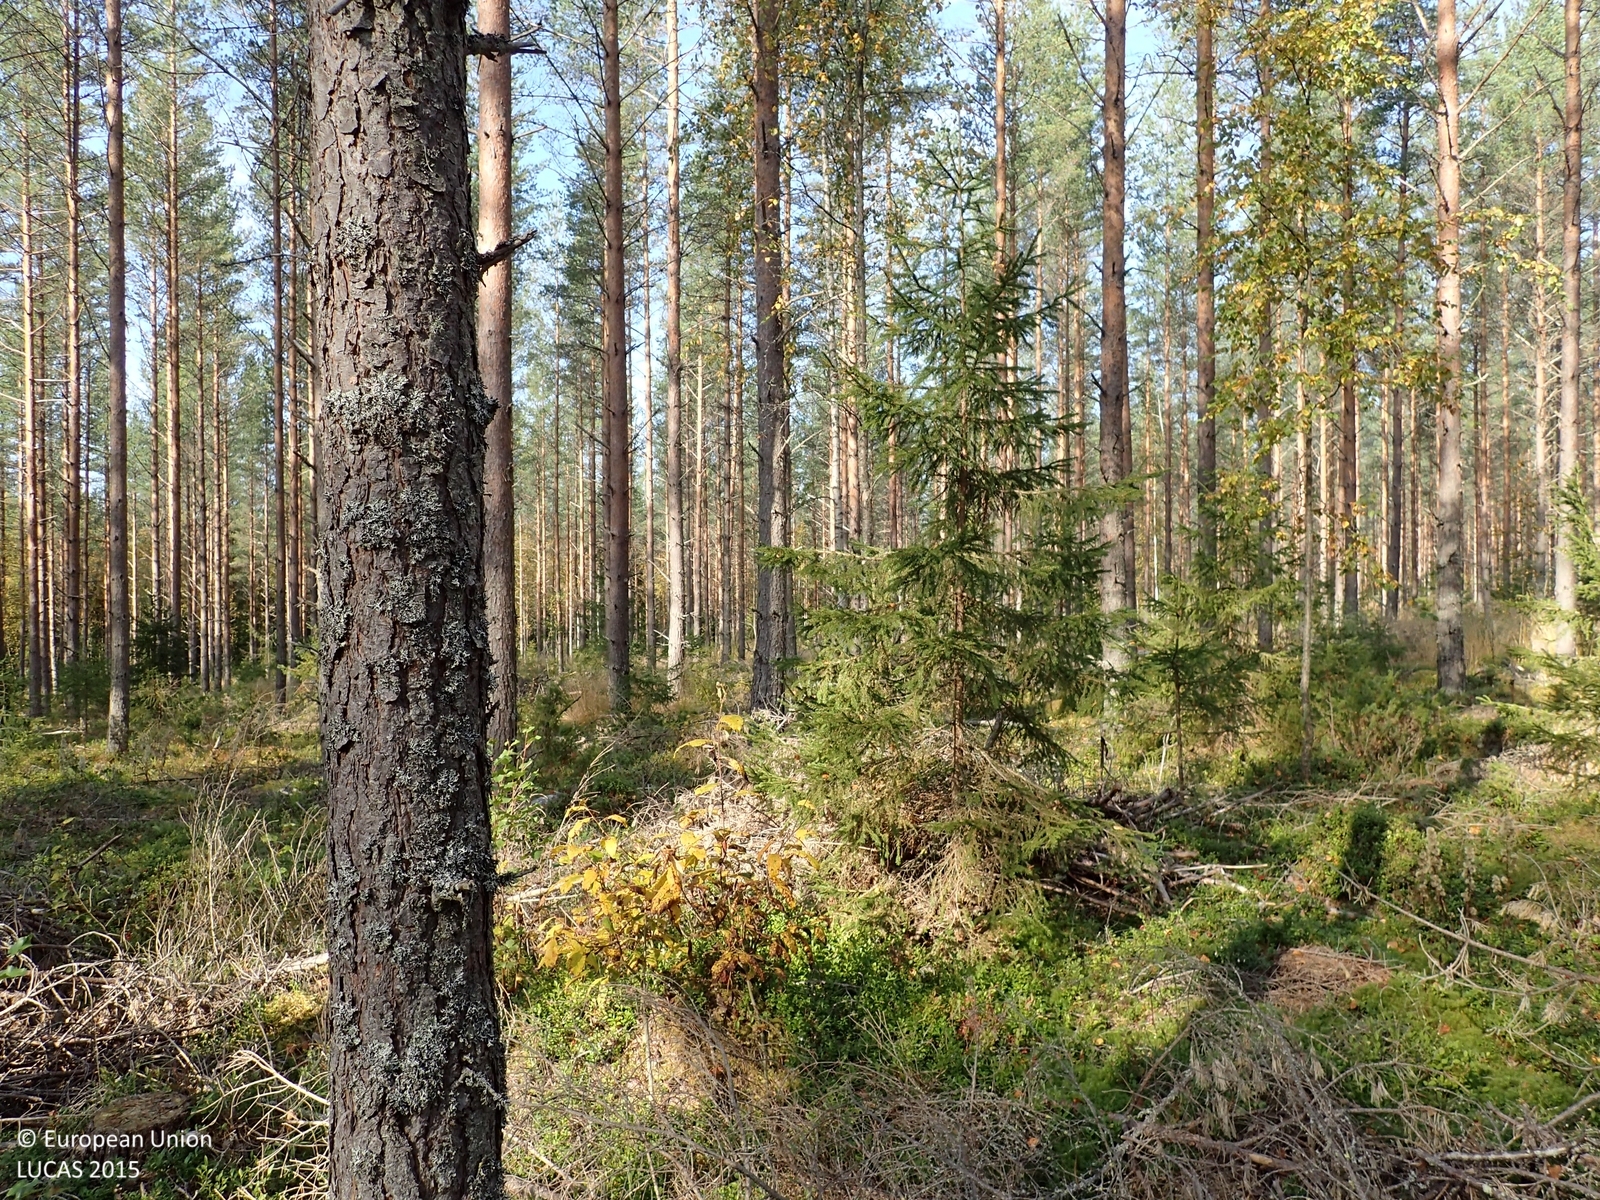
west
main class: Woodland
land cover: Pine dominated mixed woodland
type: boreal forest
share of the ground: > 75 %
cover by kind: coniferous forest trees 55 %, broadleaved forest trees 20 %, shrubs 15 %, herbaceous plants 5 %, lichens and mosses 5 %
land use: Forestry
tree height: > 5 m
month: September
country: FI
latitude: 62.9910
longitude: 25.6033
